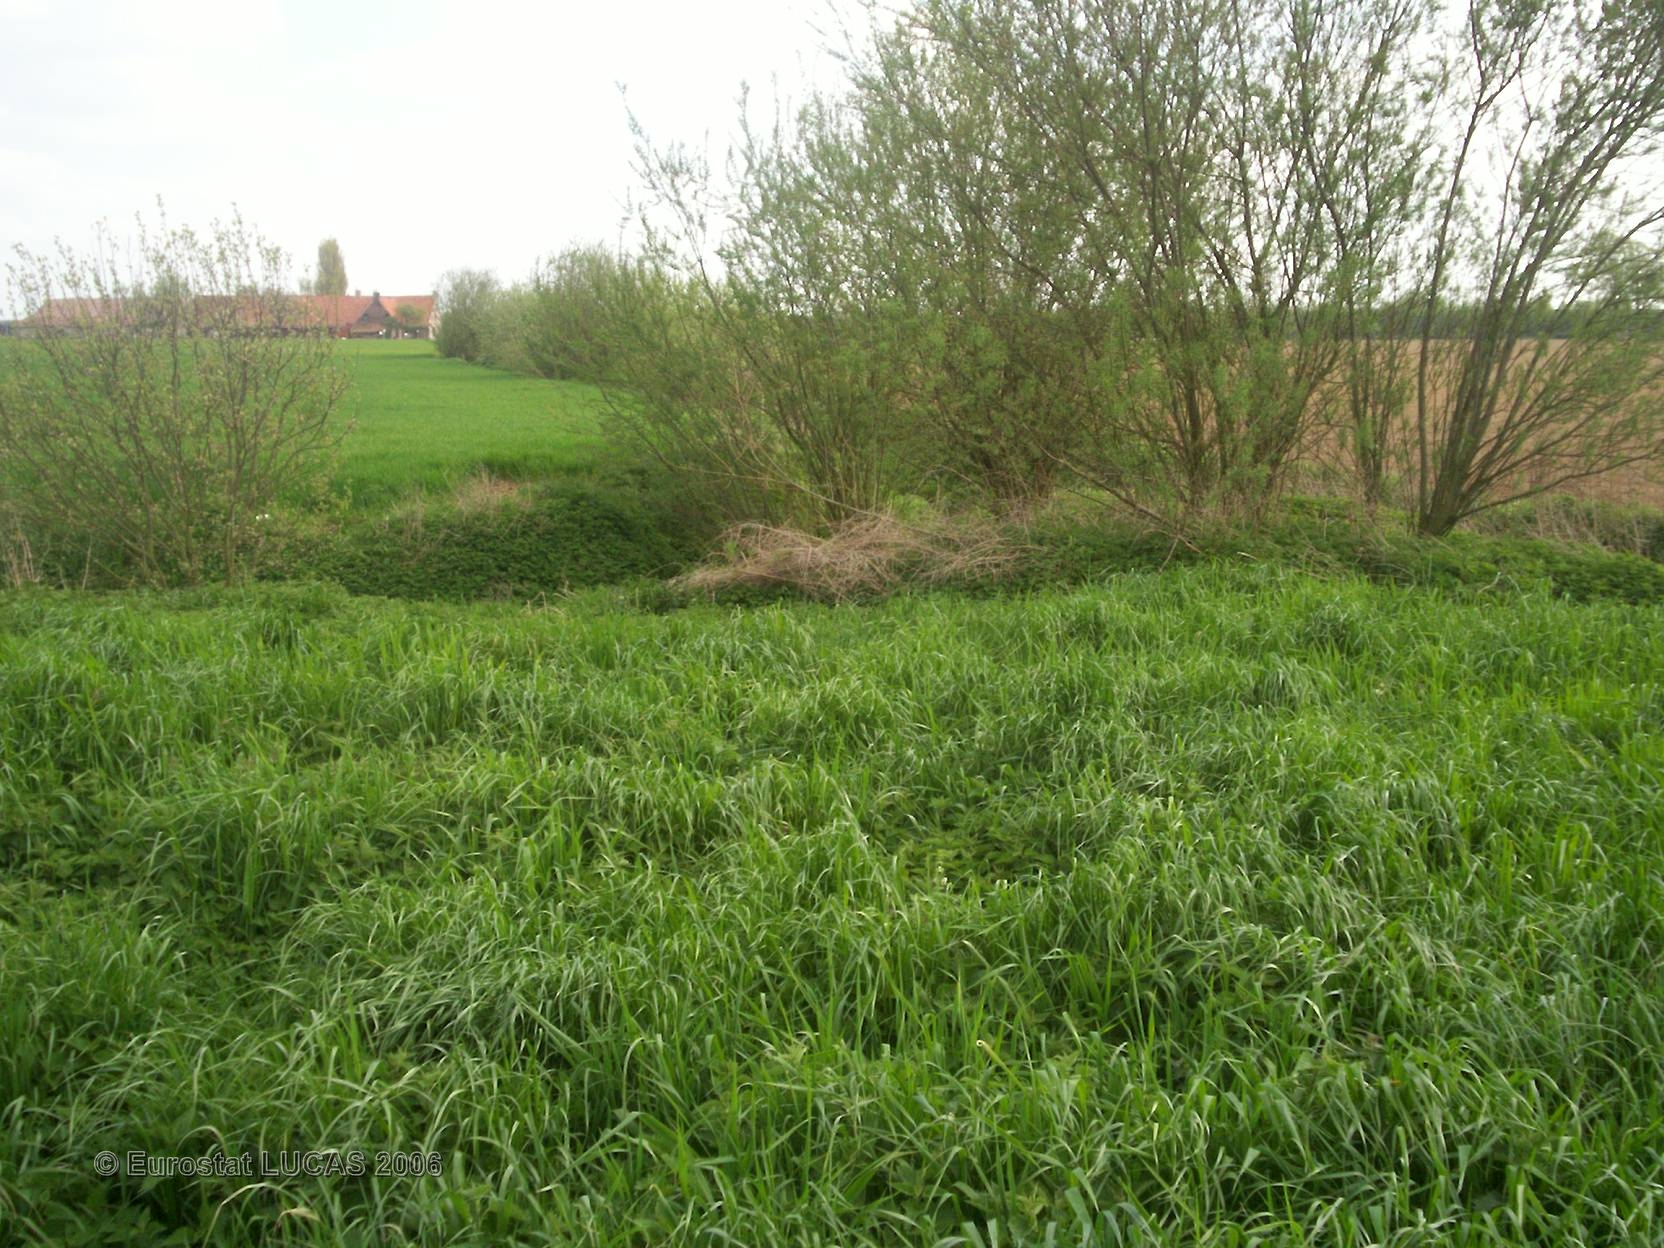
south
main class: Grassland
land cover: Grassland without tree/shrub cover
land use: Agriculture (excluding fallow land and kitchen gardens)
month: May
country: FR
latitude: 50.7546
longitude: 2.5742
